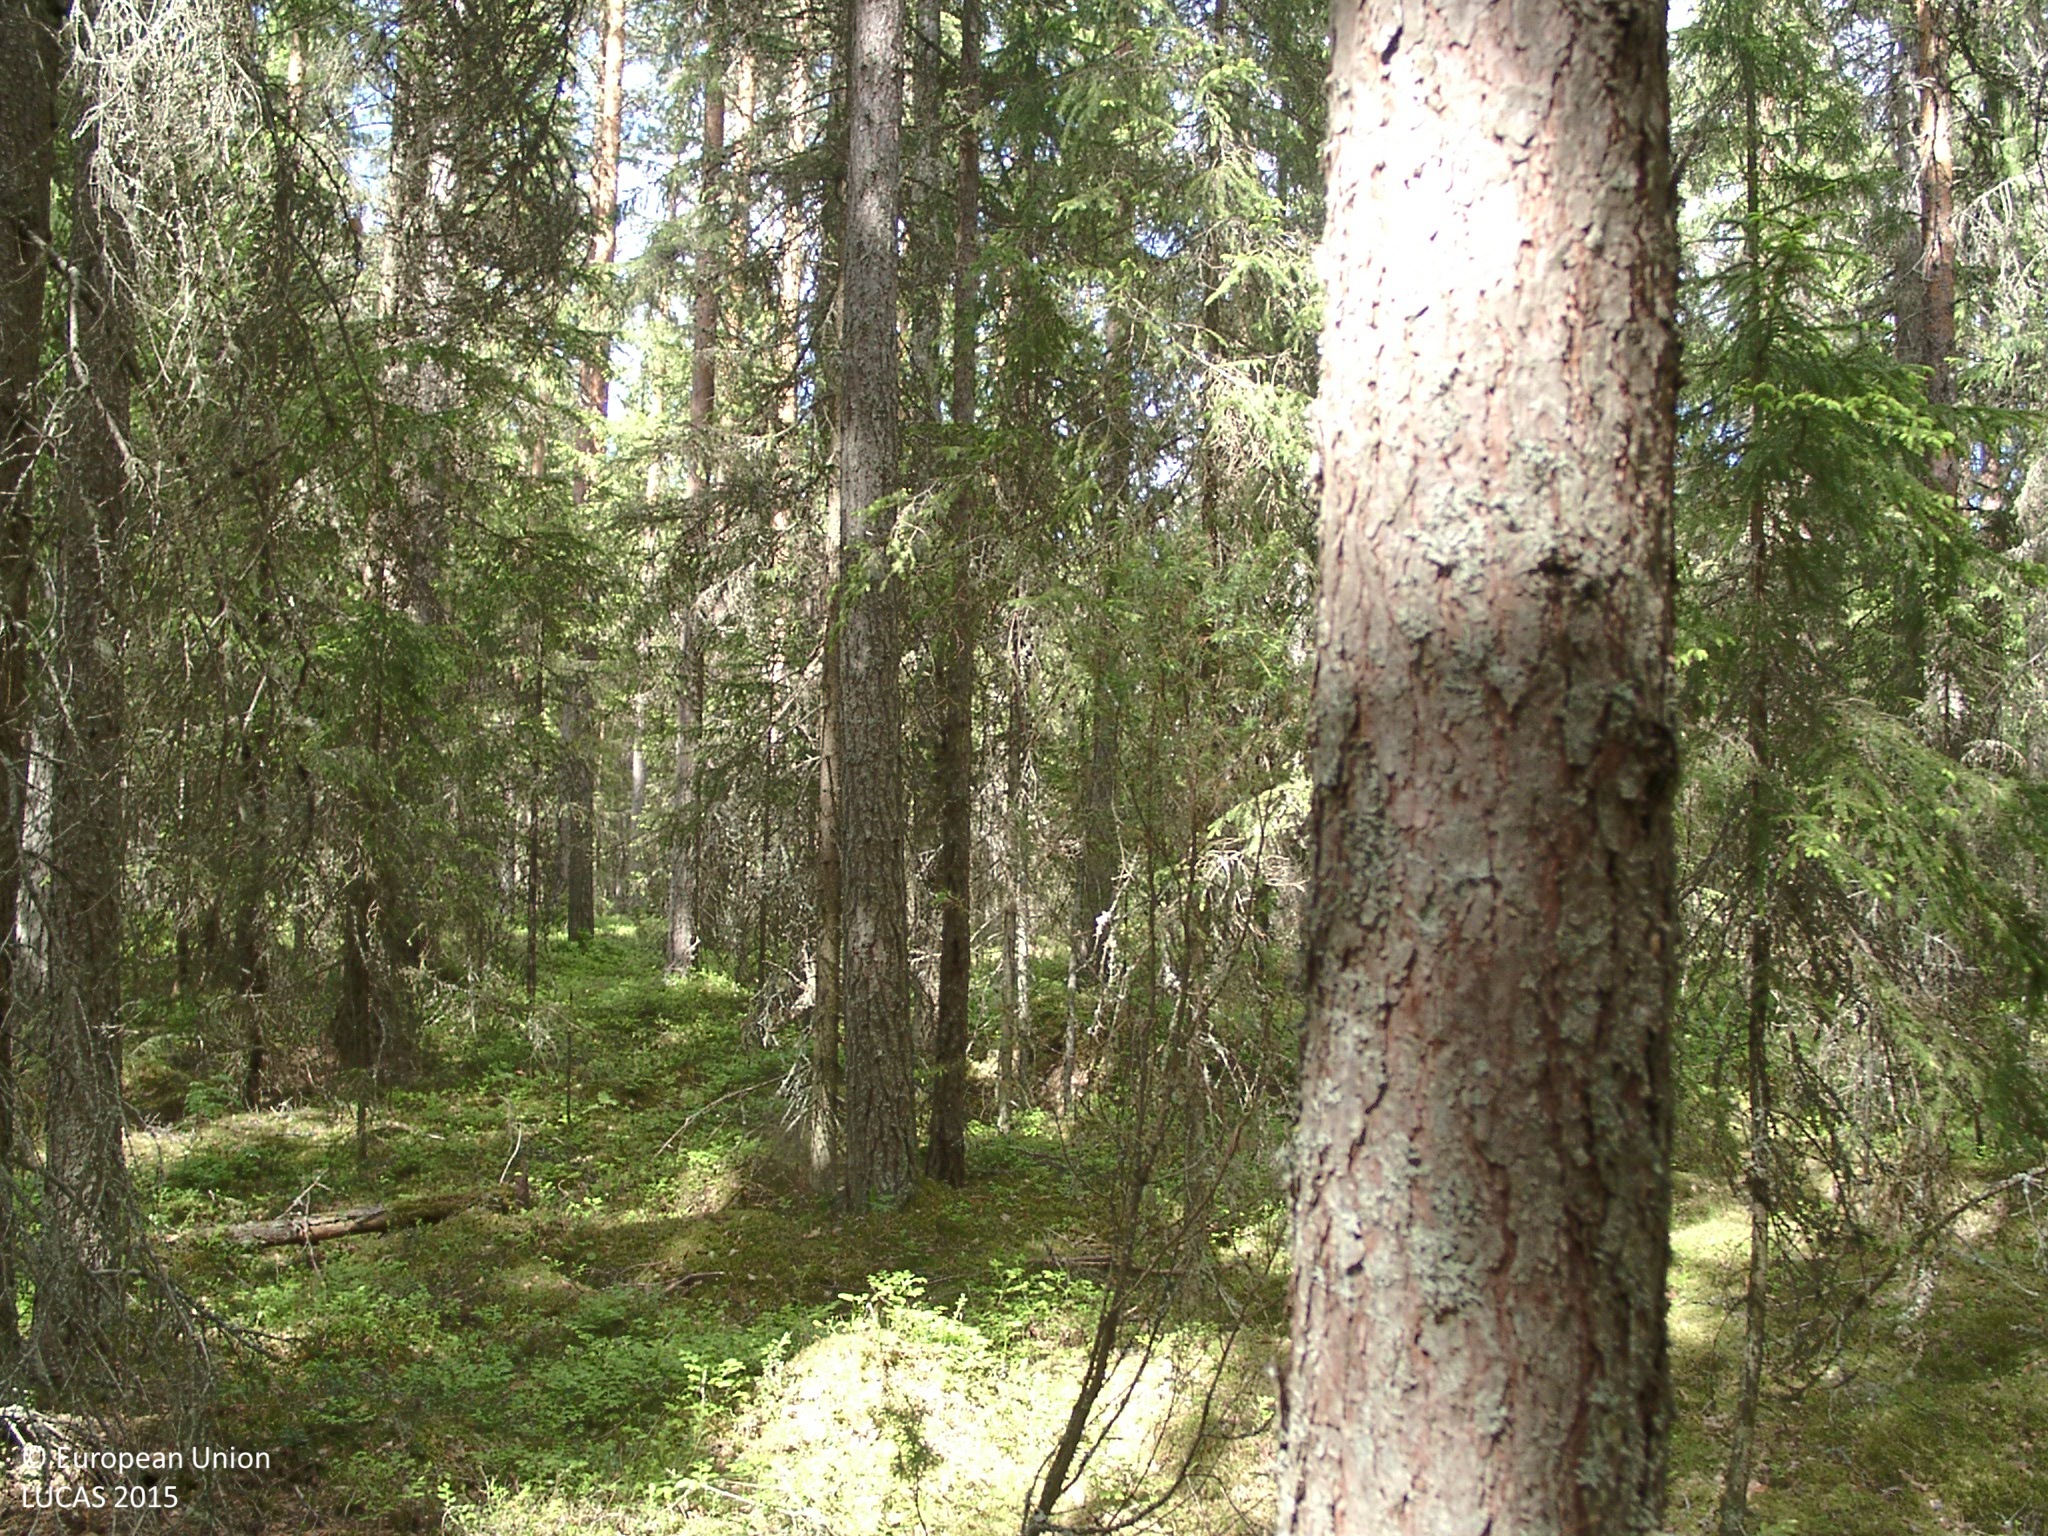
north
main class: Woodland
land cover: Other coniferous woodland
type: boreal forest
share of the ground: 50 - 75 %
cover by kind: coniferous forest trees 65 %, shrubs 15 %, lichens and mosses 15 %, broadleaved forest trees 5 %
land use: Semi-natural and natural areas not in use
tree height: > 5 m
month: June
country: FI
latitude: 62.1989
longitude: 26.1009
